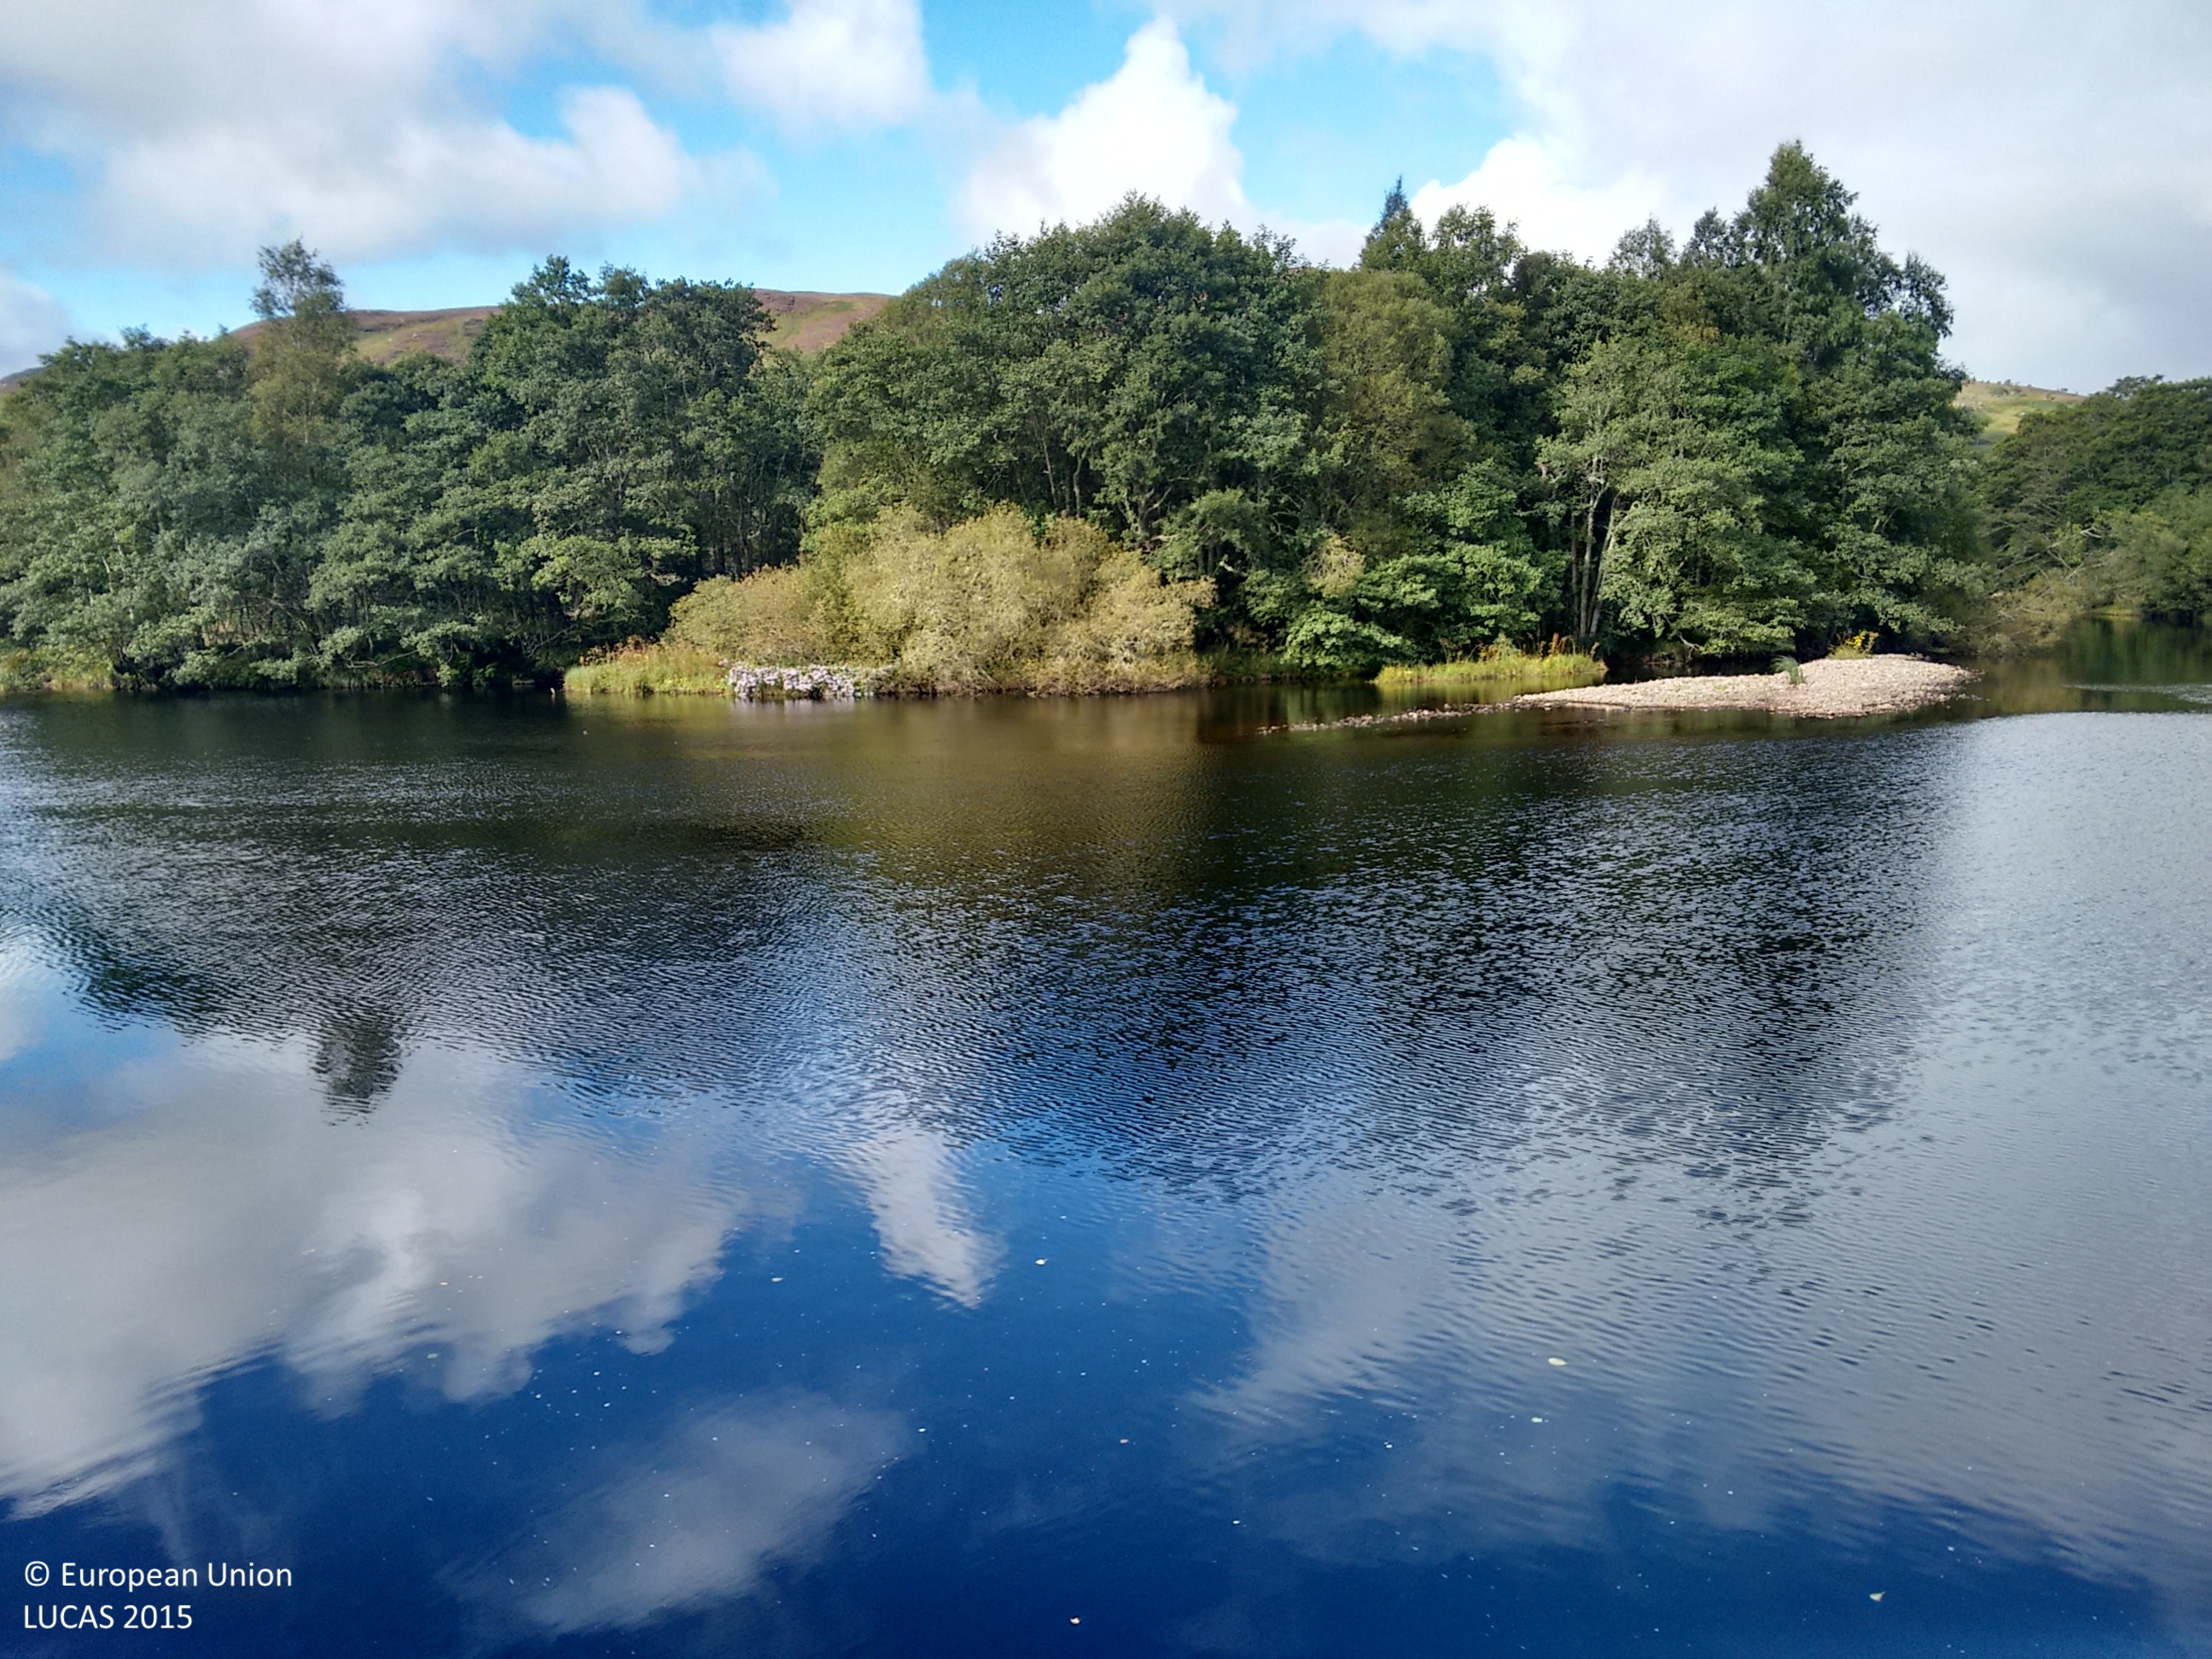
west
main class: Woodland
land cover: Broadleaved woodland
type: floodplain forest
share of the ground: > 75 %
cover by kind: broadleaved forest trees 100 %
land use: Semi-natural and natural areas not in use
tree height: > 5 m
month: September
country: GB
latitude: 57.6095
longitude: -4.6726
